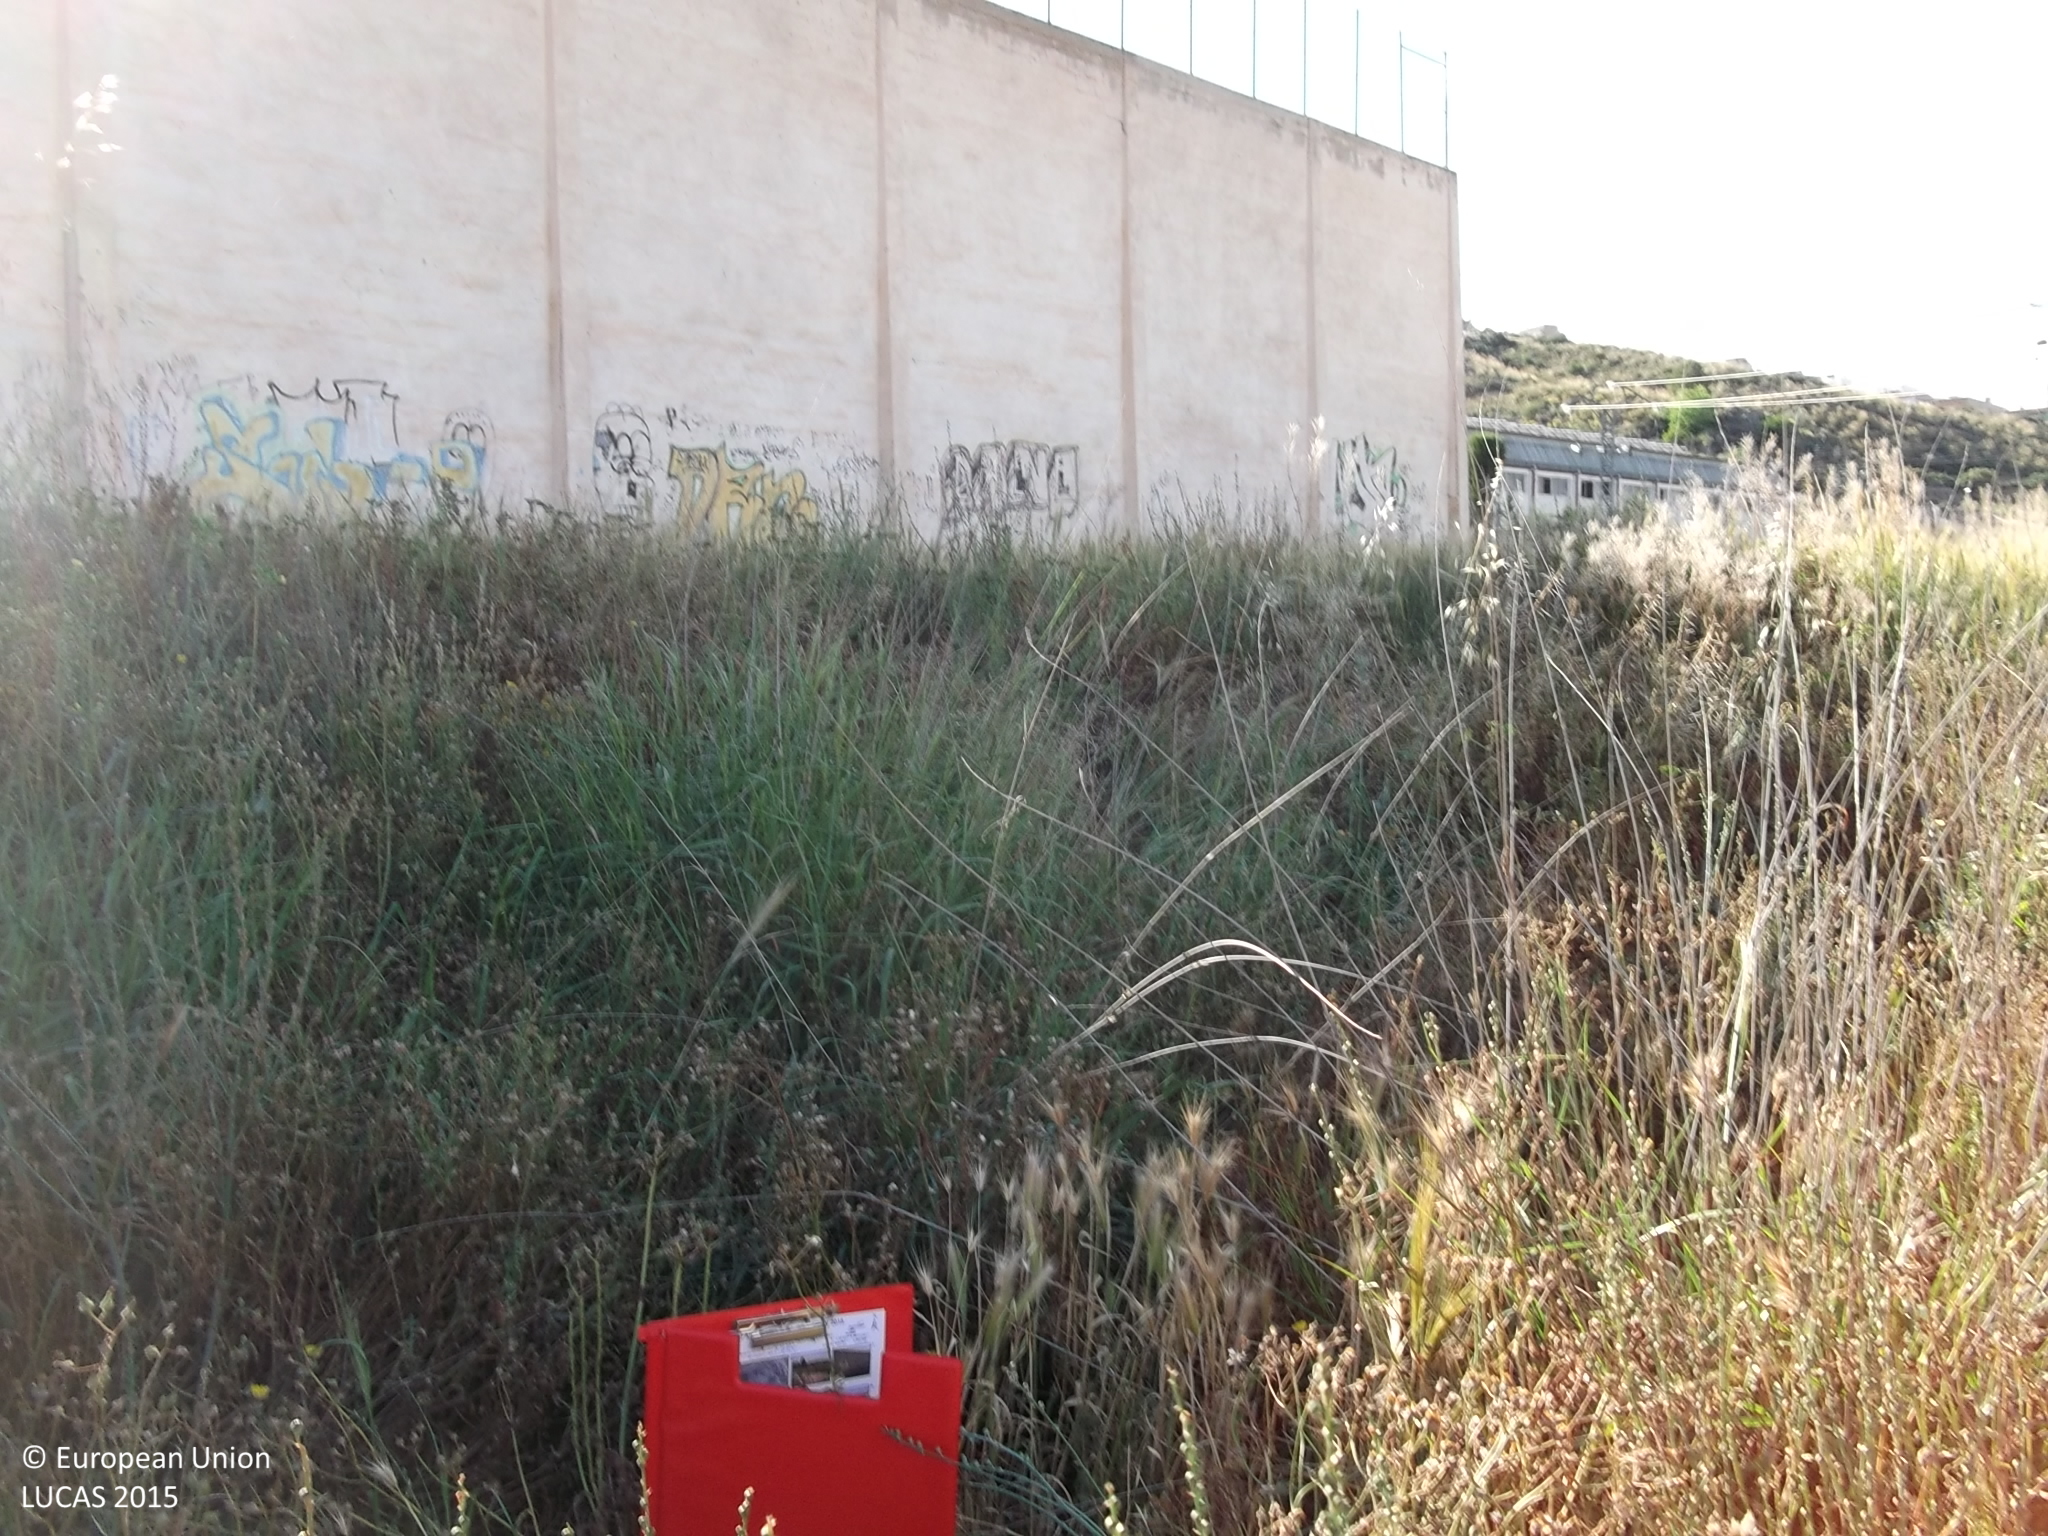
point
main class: Grassland
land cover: Spontaneously vegetated surfaces
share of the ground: > 75 %
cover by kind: herbaceous plants 90 %, consolidated bare surface 10 %
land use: Abandoned areas
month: April
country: ES
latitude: 38.2123
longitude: -1.3975
